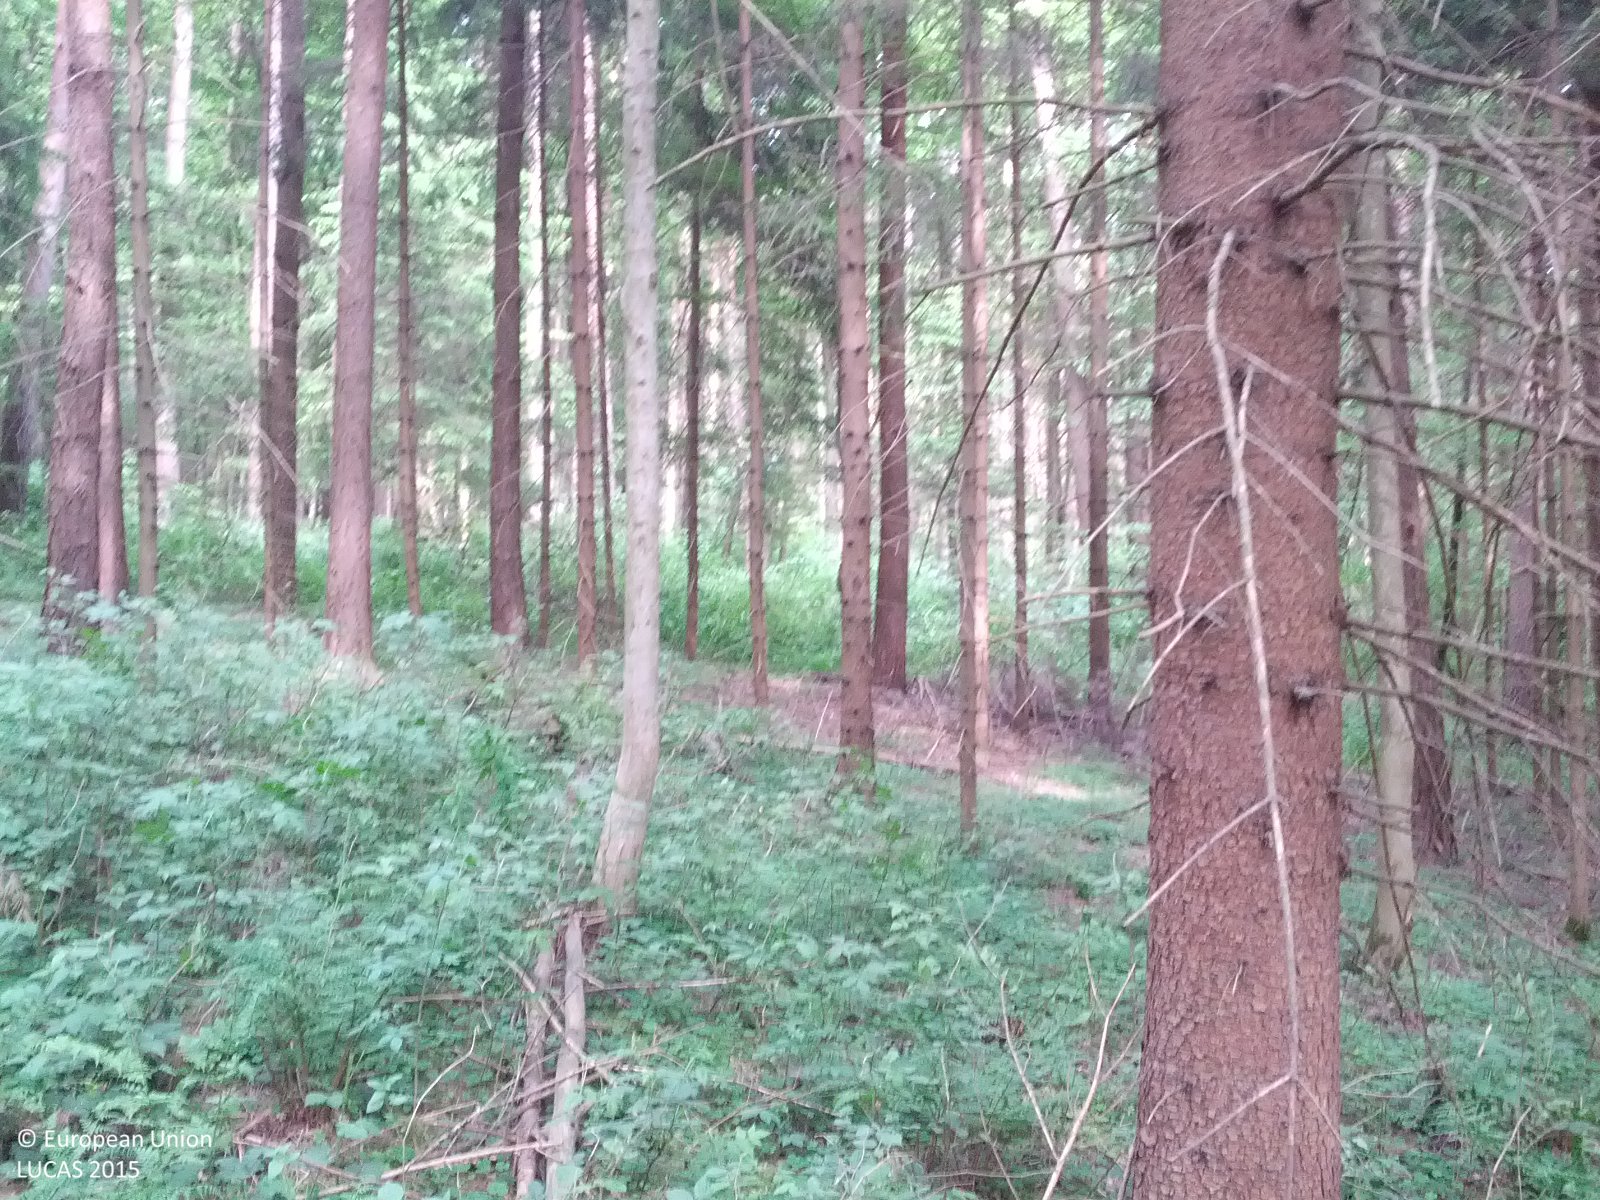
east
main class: Woodland
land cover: Pine dominated coniferous woodland
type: hemiboreal forest and nemoral coniferous forest and mixed broadleaved-coniferous forest
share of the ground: > 75 %
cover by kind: coniferous forest trees 70 %, broadleaved forest trees 10 %, herbaceous plants 10 %, shrubs 5 %, lichens and mosses 5 %
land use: Forestry
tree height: > 5 m
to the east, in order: Pine dominated coniferous woodland; Grass margins; Pine dominated coniferous woodland; Tracks; Pine dominated mixed woodland; Spruce dominated coniferous woodland
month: May
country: AT
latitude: 47.3505
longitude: 16.1048
